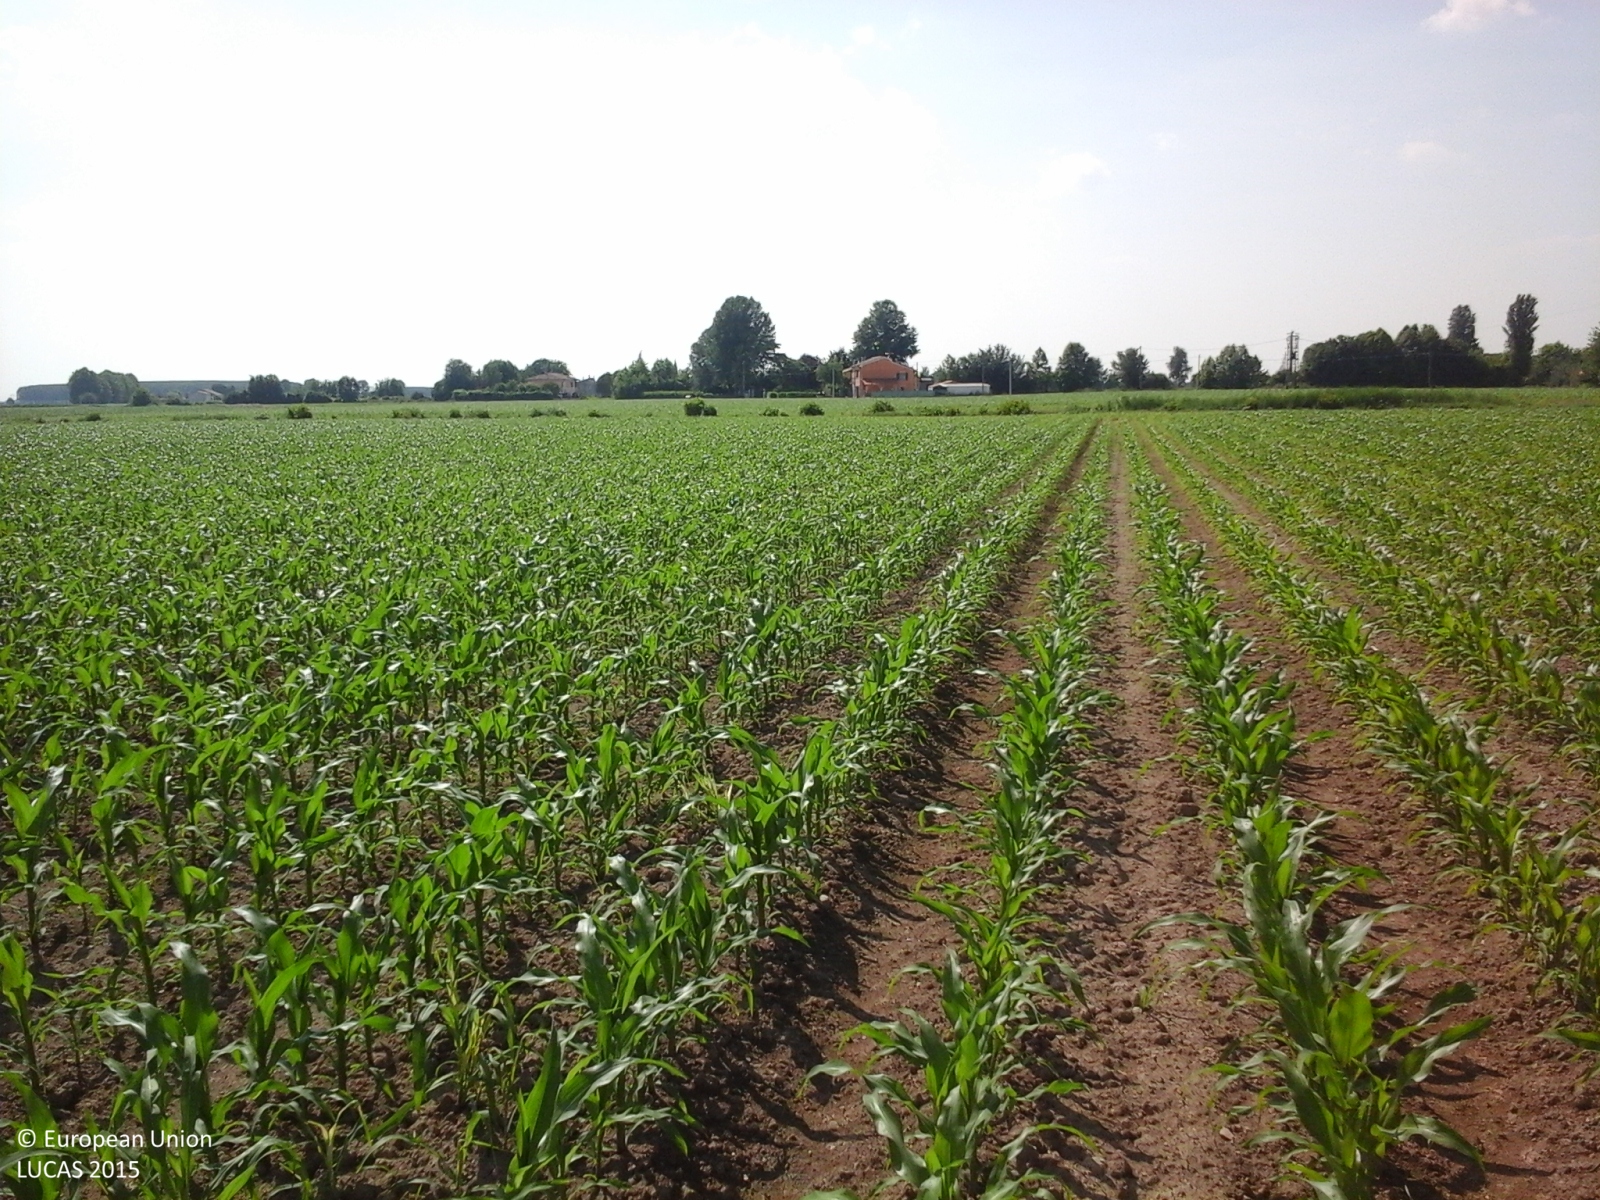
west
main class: Cropland
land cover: Maize
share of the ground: 25 - 50 %
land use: Agriculture (excluding fallow land and kitchen gardens)
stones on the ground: < 10 %
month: May
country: IT
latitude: 45.2119
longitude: 10.9278
